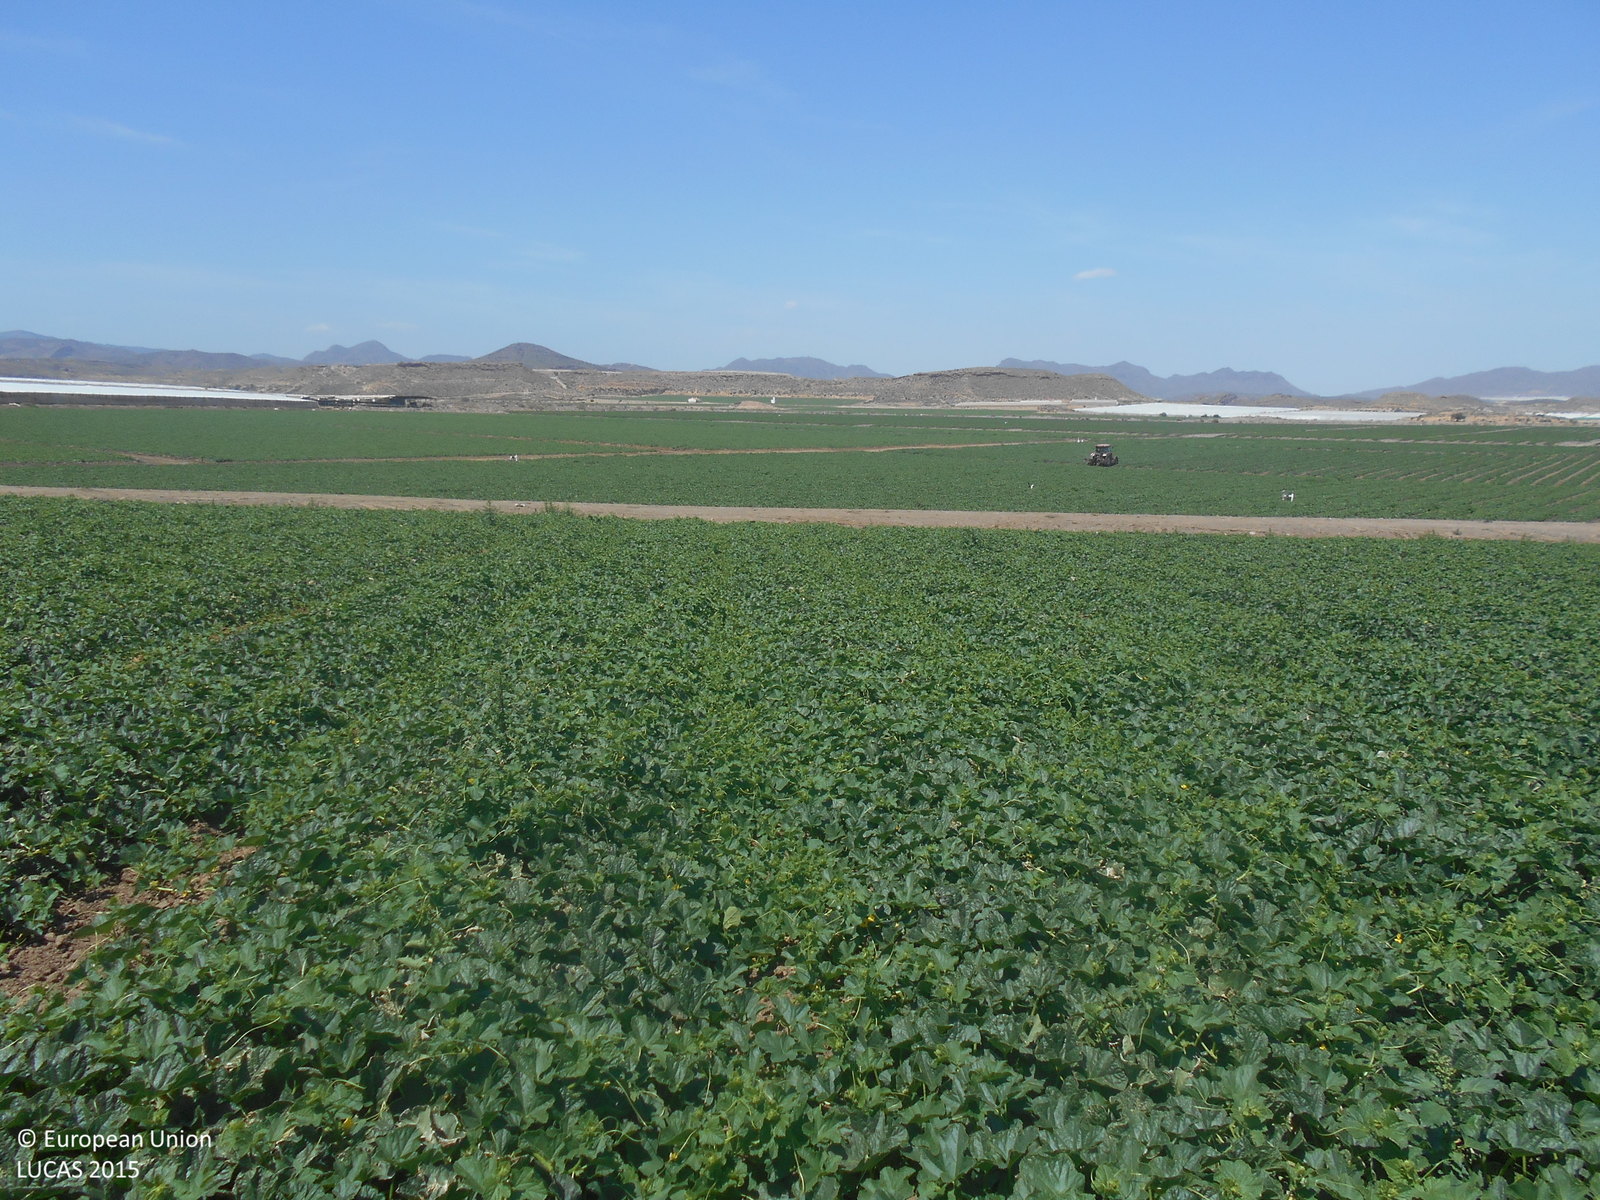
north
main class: Cropland
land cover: Other fresh vegetables
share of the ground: > 75 %
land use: Agriculture (excluding fallow land and kitchen gardens)
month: May
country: ES
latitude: 37.5150
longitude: -1.4174
